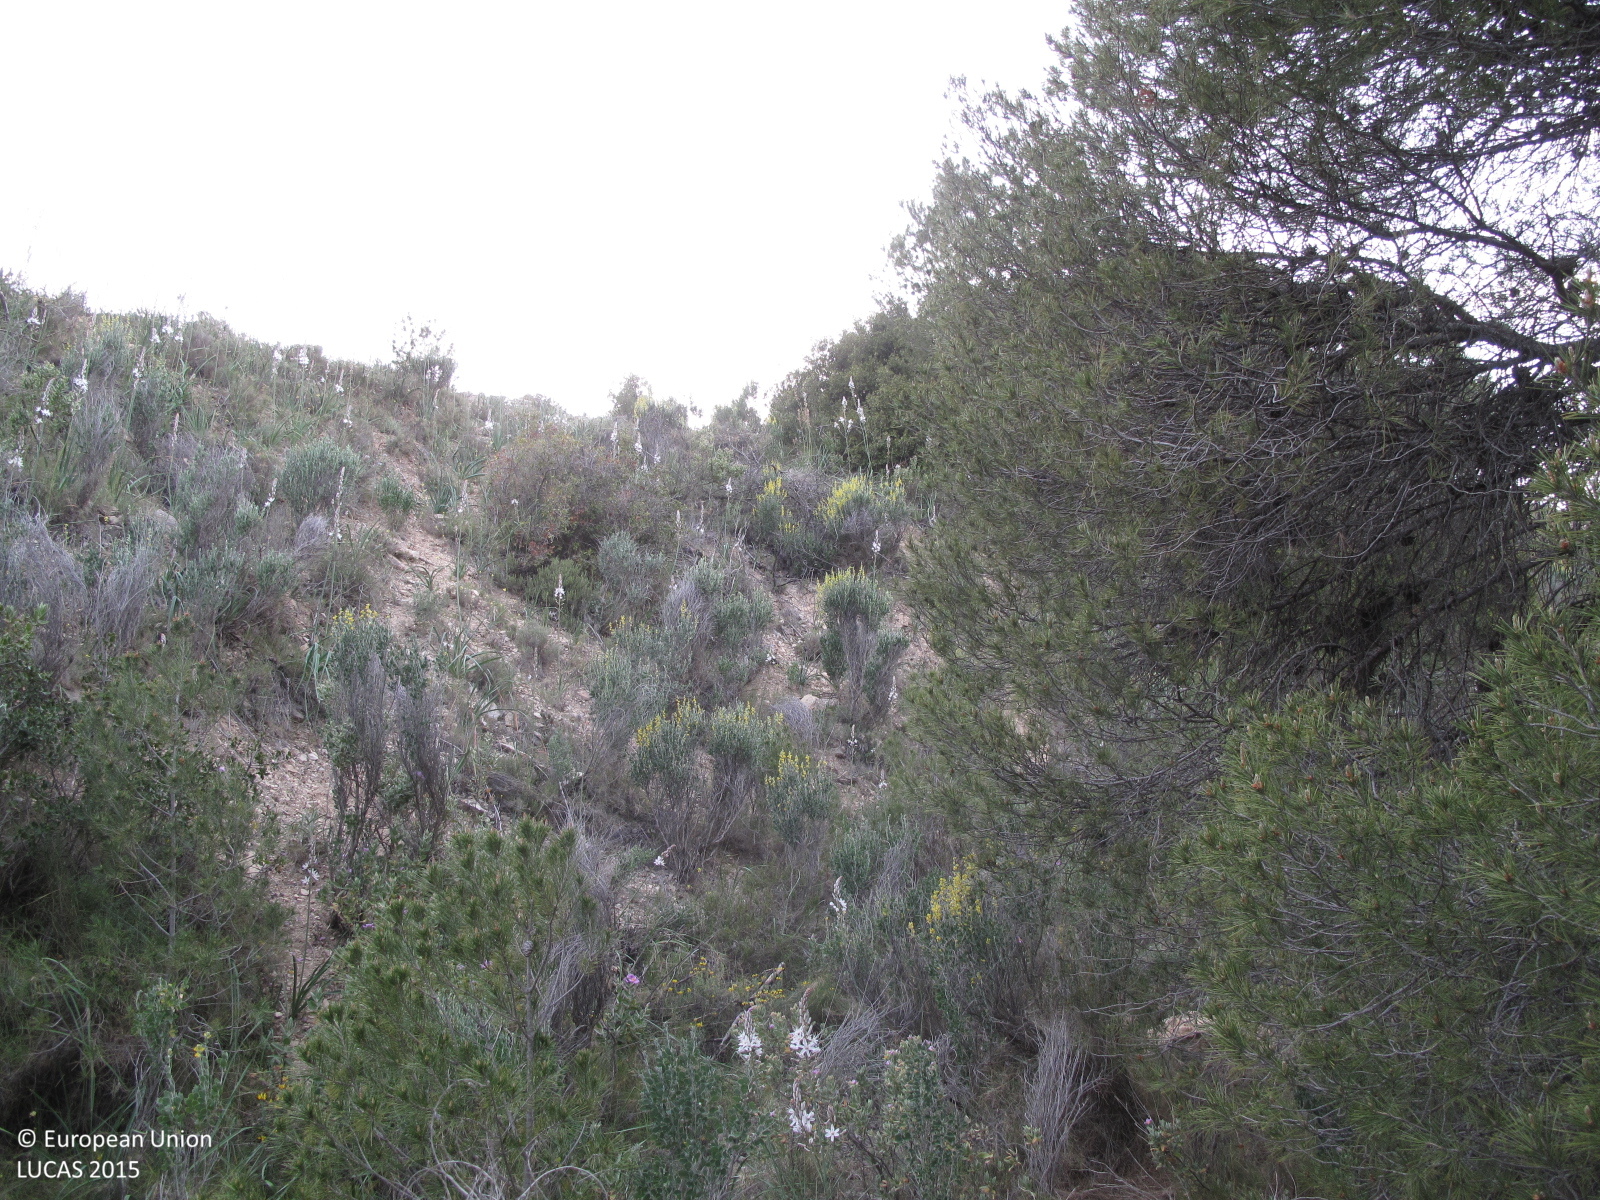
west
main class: Woodland
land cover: Pine dominated coniferous woodland
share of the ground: 25 - 50 %
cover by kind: coniferous forest trees 40 %, shrubs 30 %, herbaceous plants 20 %, consolidated bare surface 10 %
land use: Semi-natural and natural areas not in use
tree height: > 5 m
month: April
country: ES
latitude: 38.4984
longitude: -0.6628
